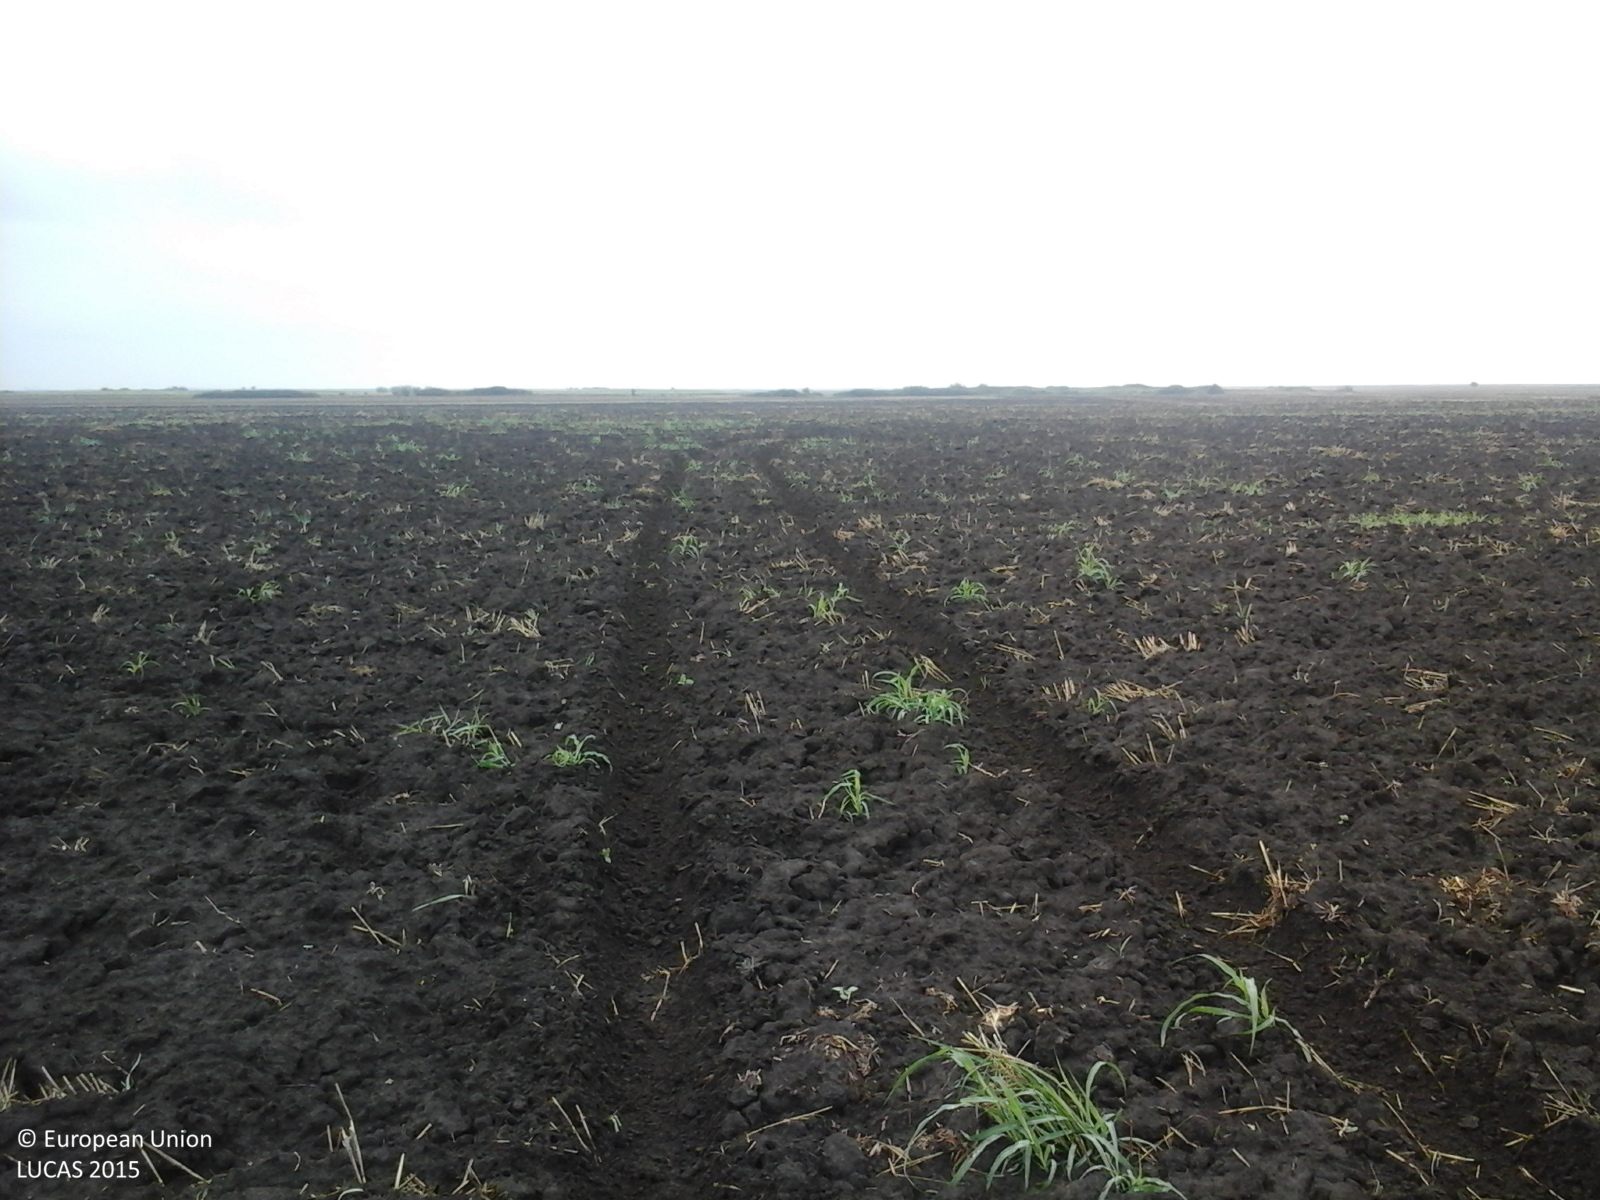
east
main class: Cropland
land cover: Common wheat
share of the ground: < 10 %
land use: Agriculture (excluding fallow land and kitchen gardens)
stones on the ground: < 10 %
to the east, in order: Common wheat
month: August
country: RO
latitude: 46.0172
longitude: 20.4733
